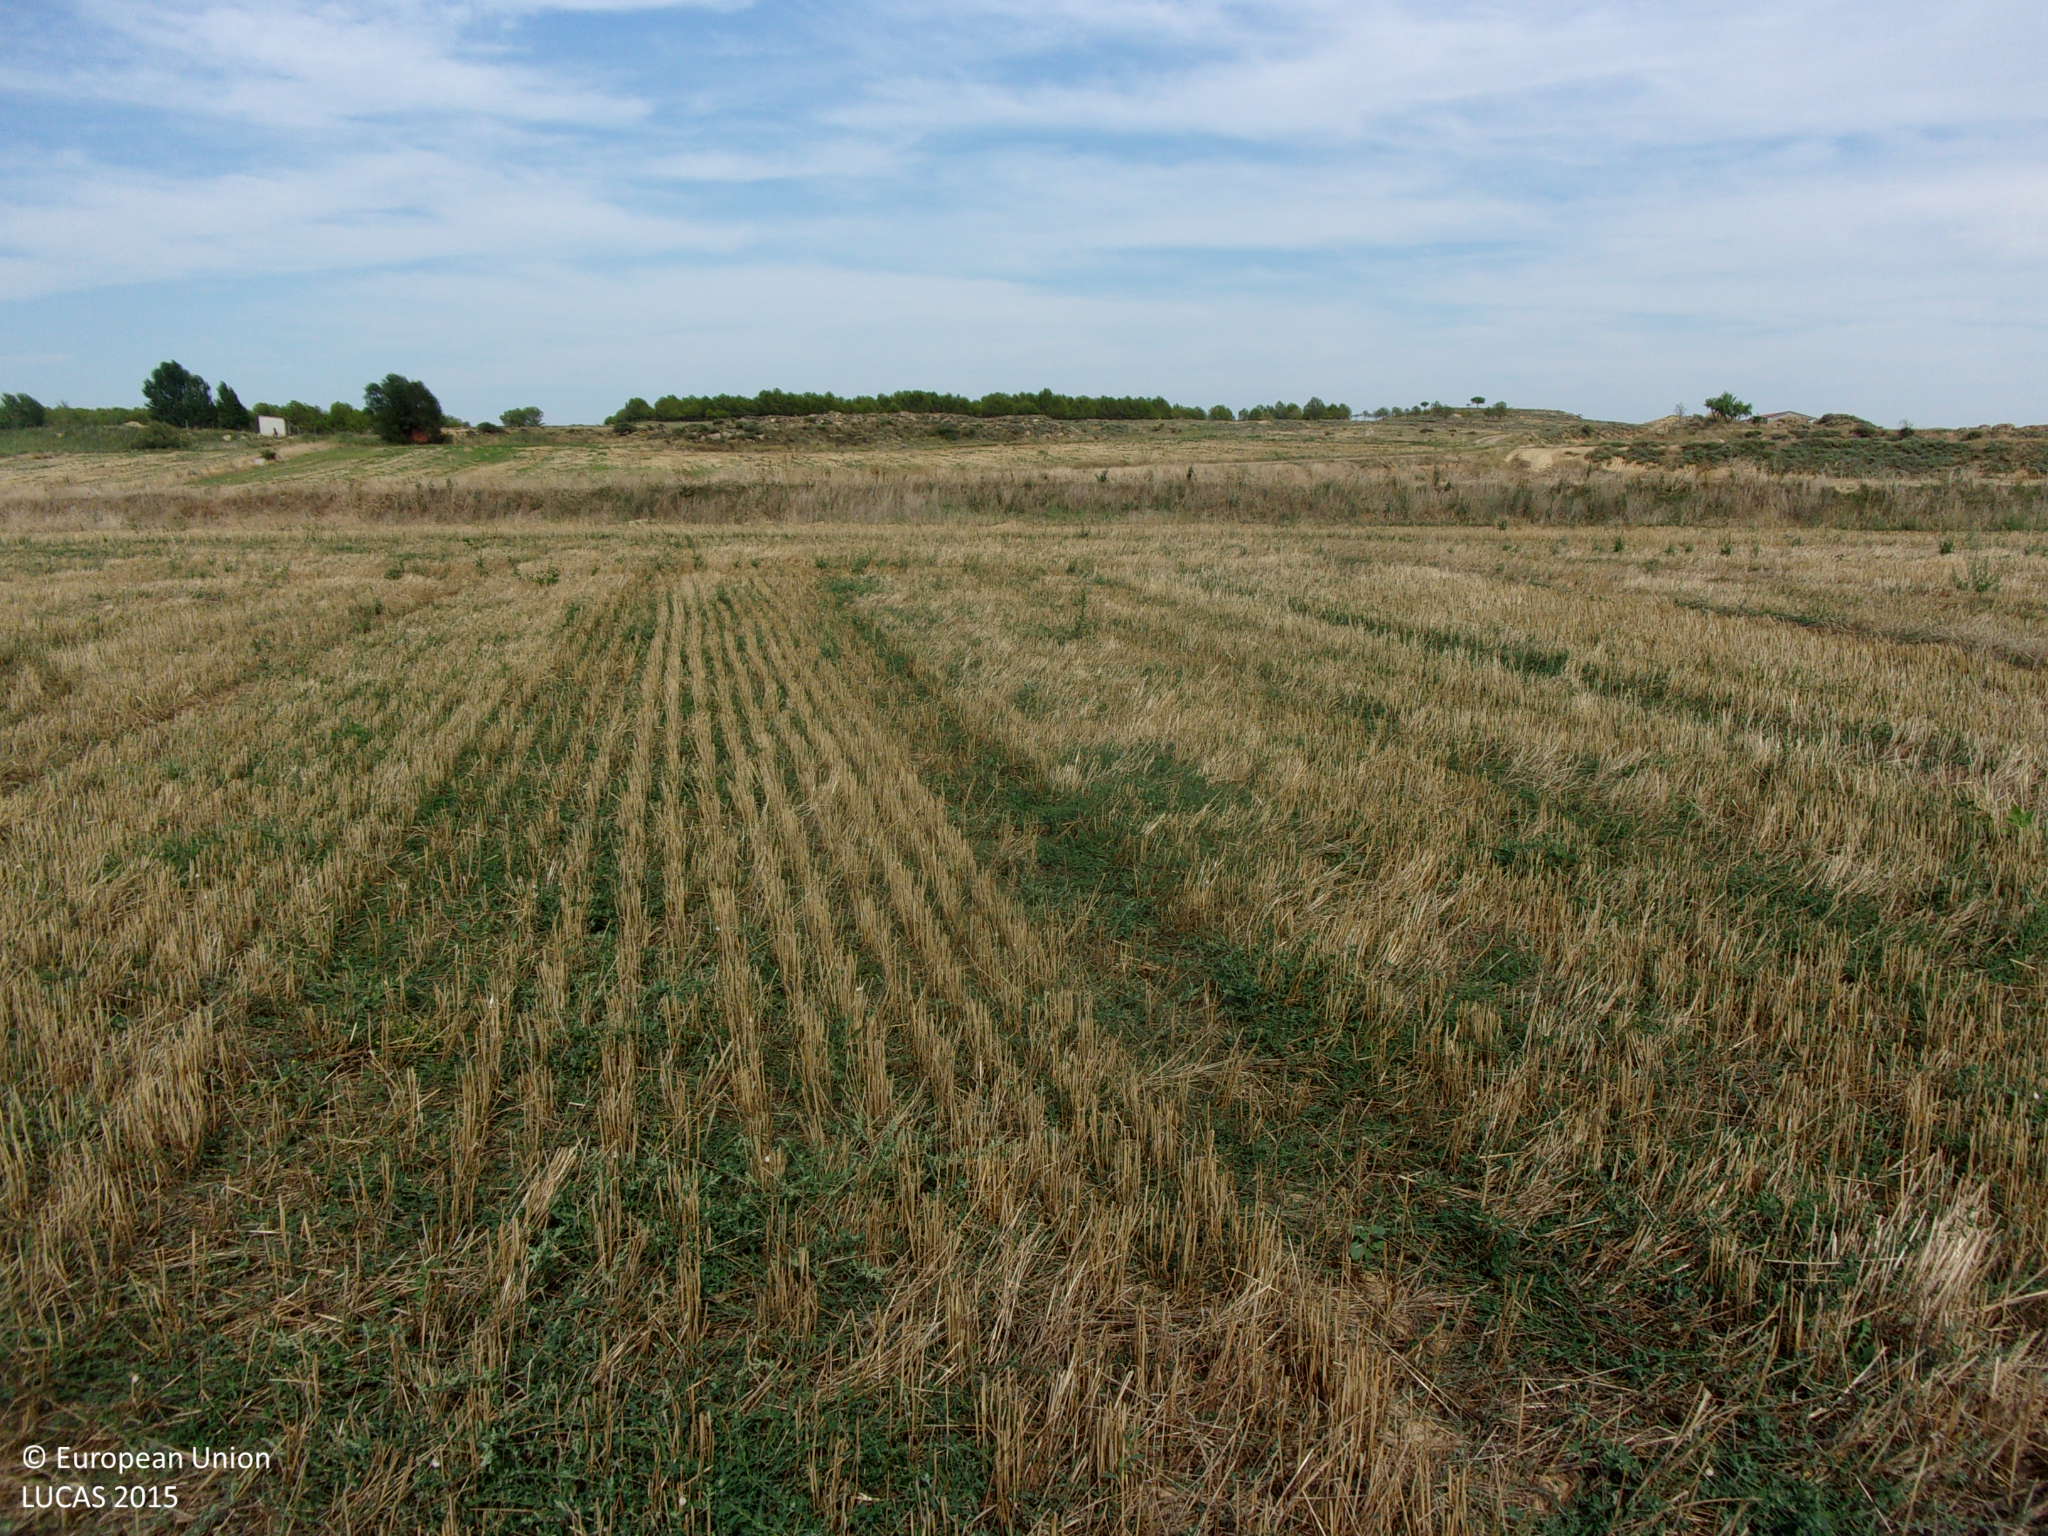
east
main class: Cropland
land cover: Durum wheat
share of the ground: < 10 %
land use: Agriculture (excluding fallow land and kitchen gardens)
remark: Harvested field
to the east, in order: Durum wheat; Grass margins; Ditches and canals; Shruby margins; Barley; Grass margins; Tracks; Grass margins; Common wheat
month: August
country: ES
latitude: 42.2199
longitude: -1.1381
